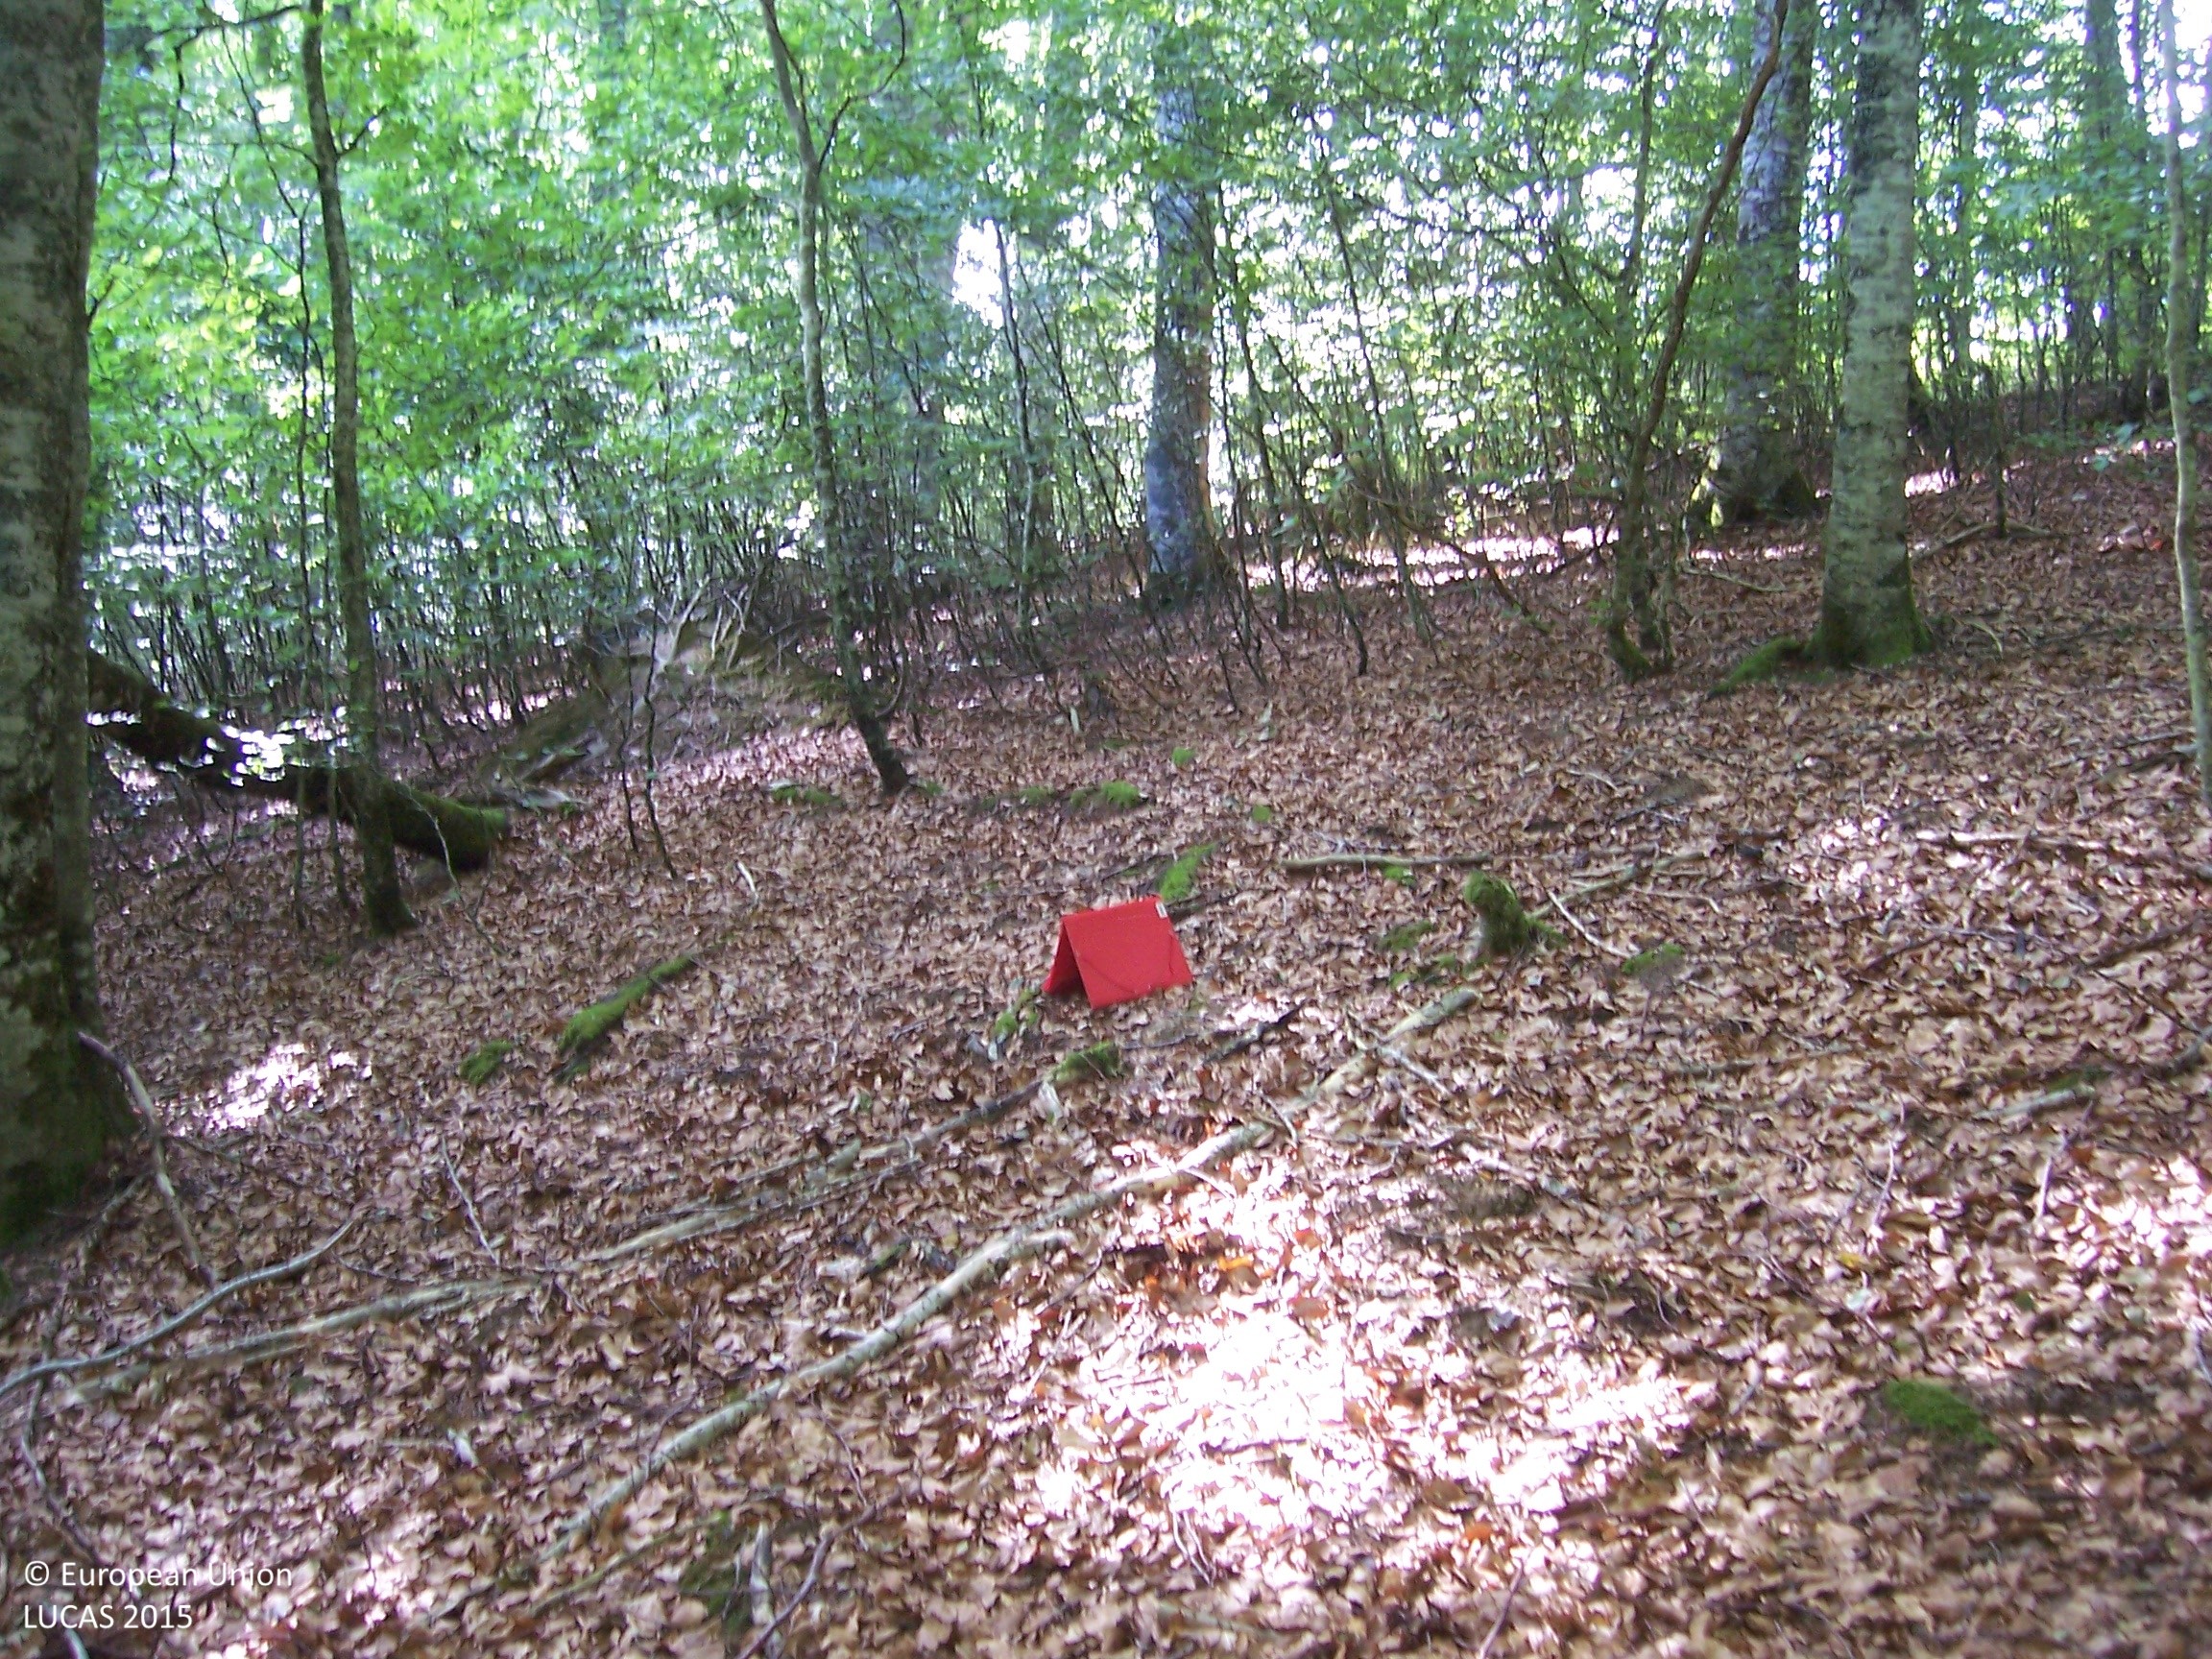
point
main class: Woodland
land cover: Broadleaved woodland
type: mountainous beech forest
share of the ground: > 75 %
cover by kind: broadleaved forest trees 100 %
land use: Forestry
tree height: > 5 m
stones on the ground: < 10 %
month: July
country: ES
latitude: 42.9770
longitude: -1.2070
